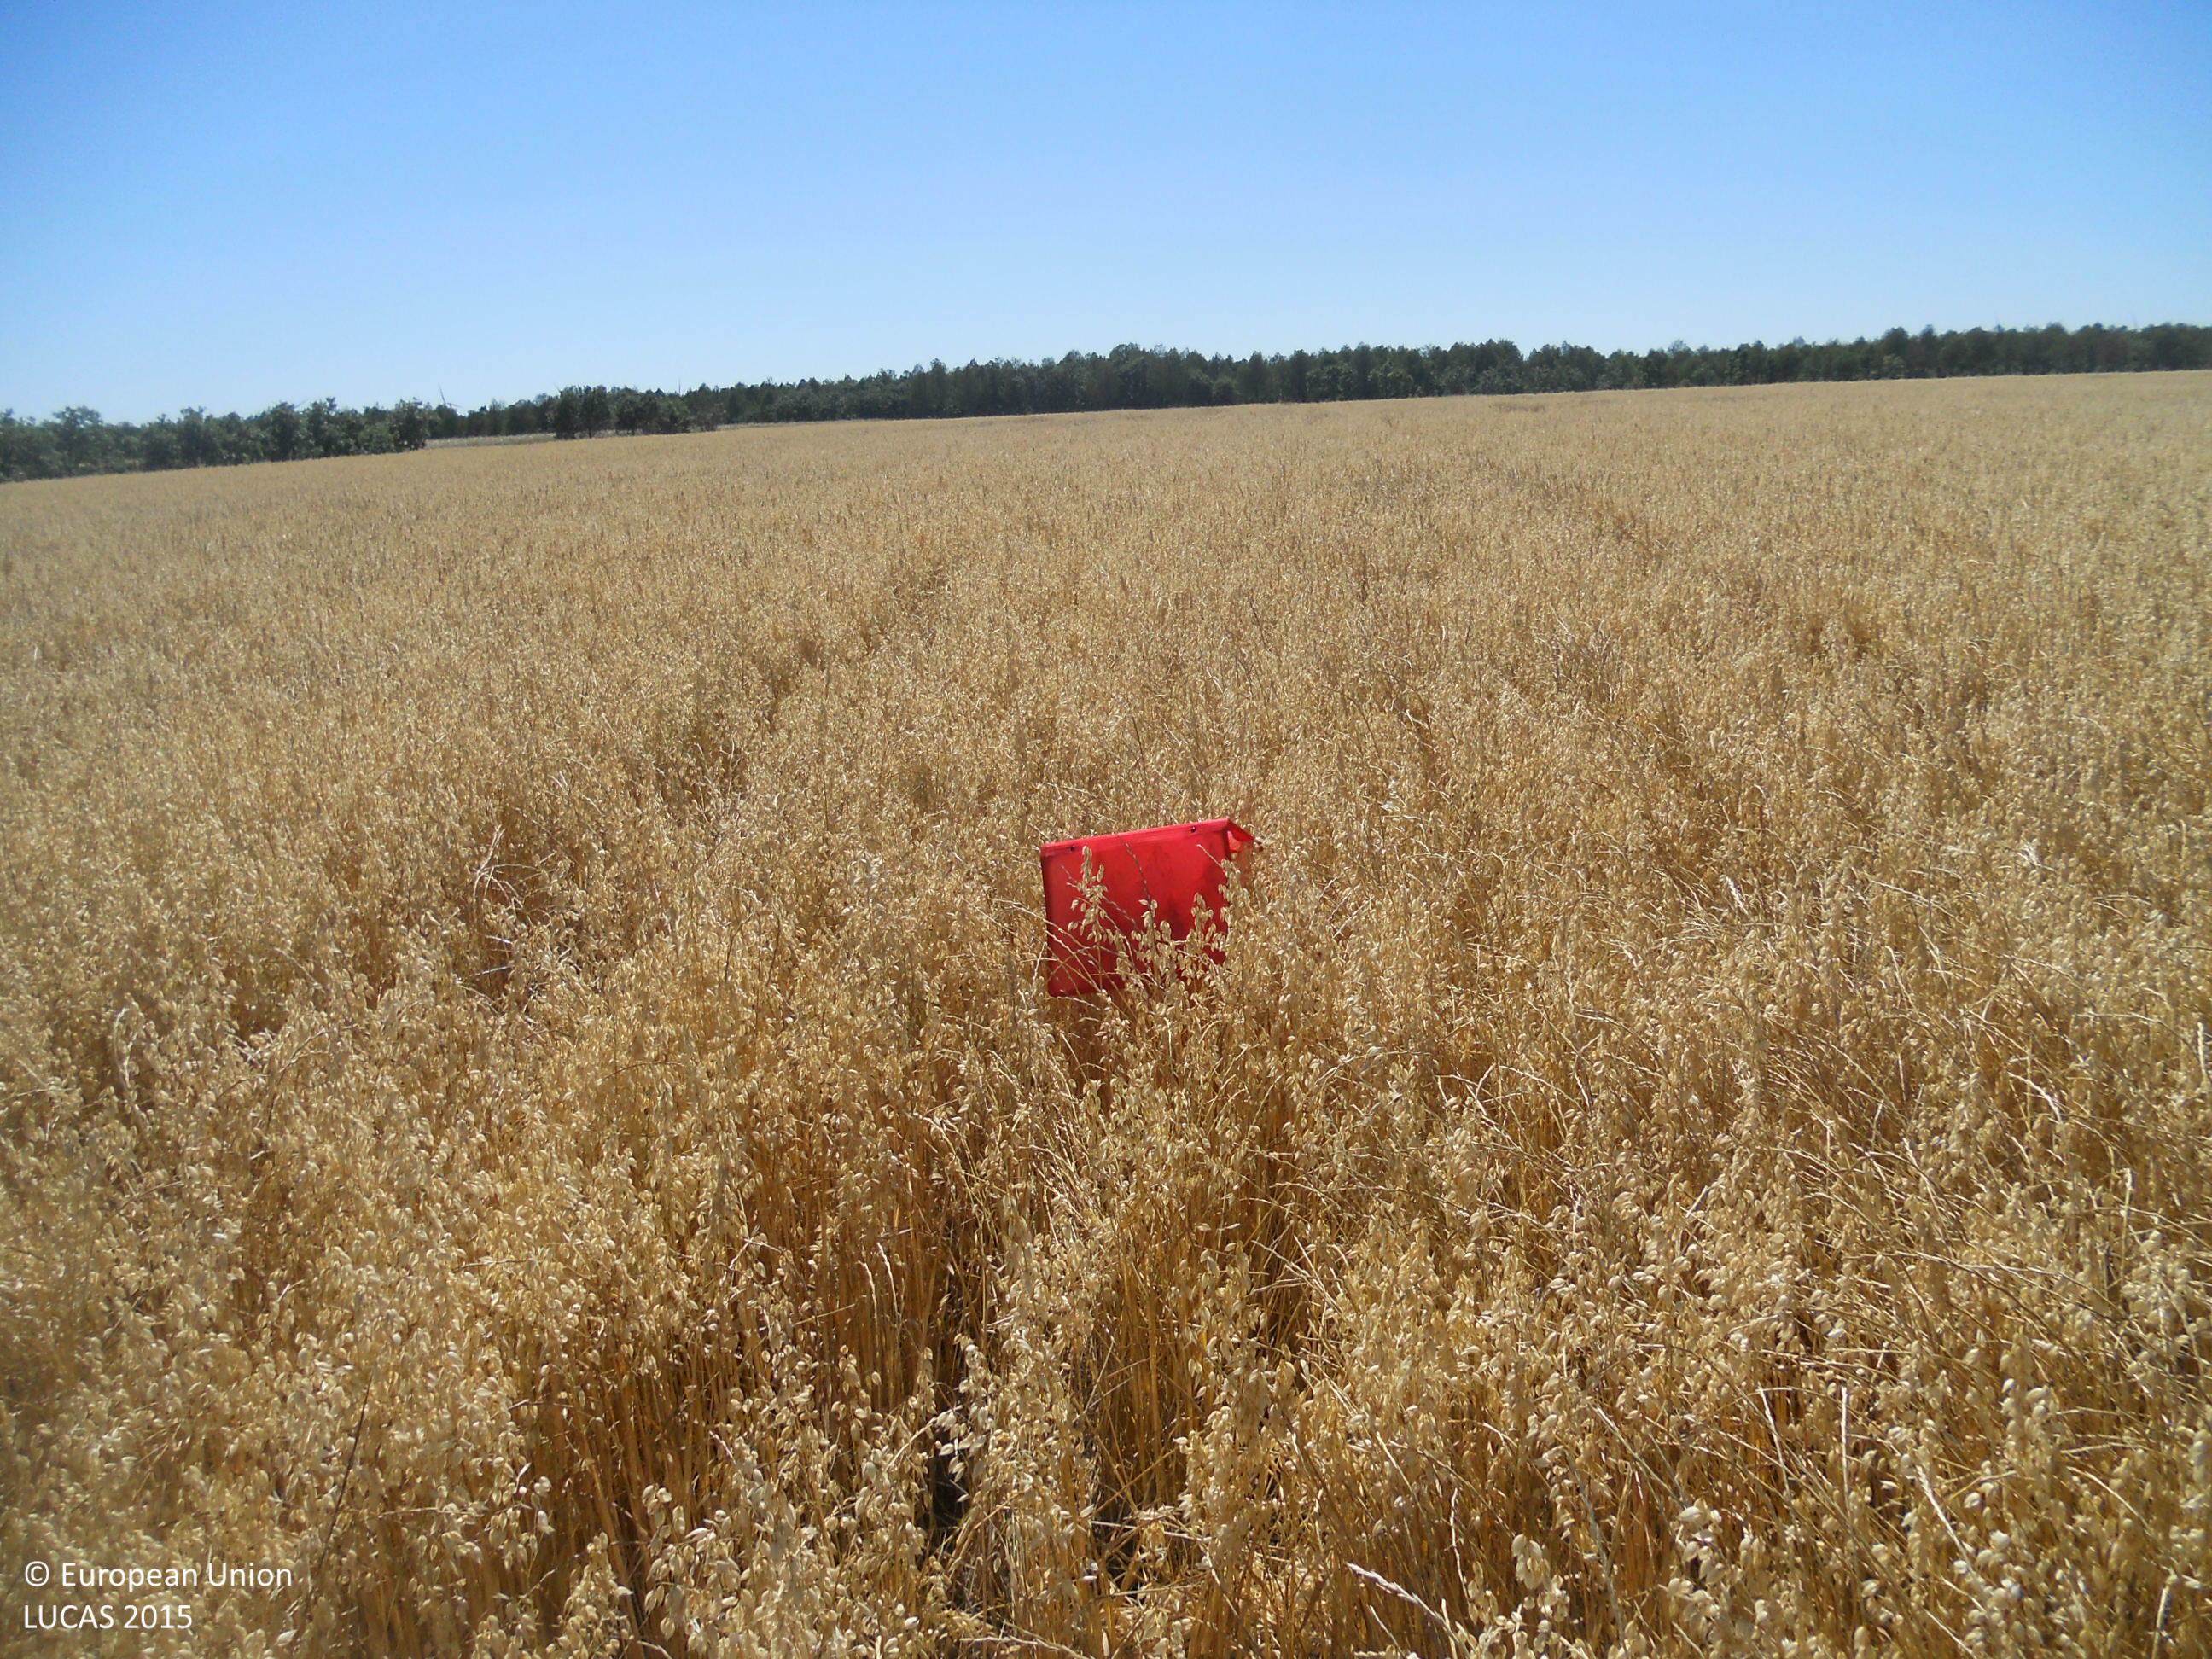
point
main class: Cropland
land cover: Oats
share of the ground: > 75 %
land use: Agriculture (excluding fallow land and kitchen gardens)
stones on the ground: > 50 %
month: June
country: ES
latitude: 42.4110
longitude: -4.8692
